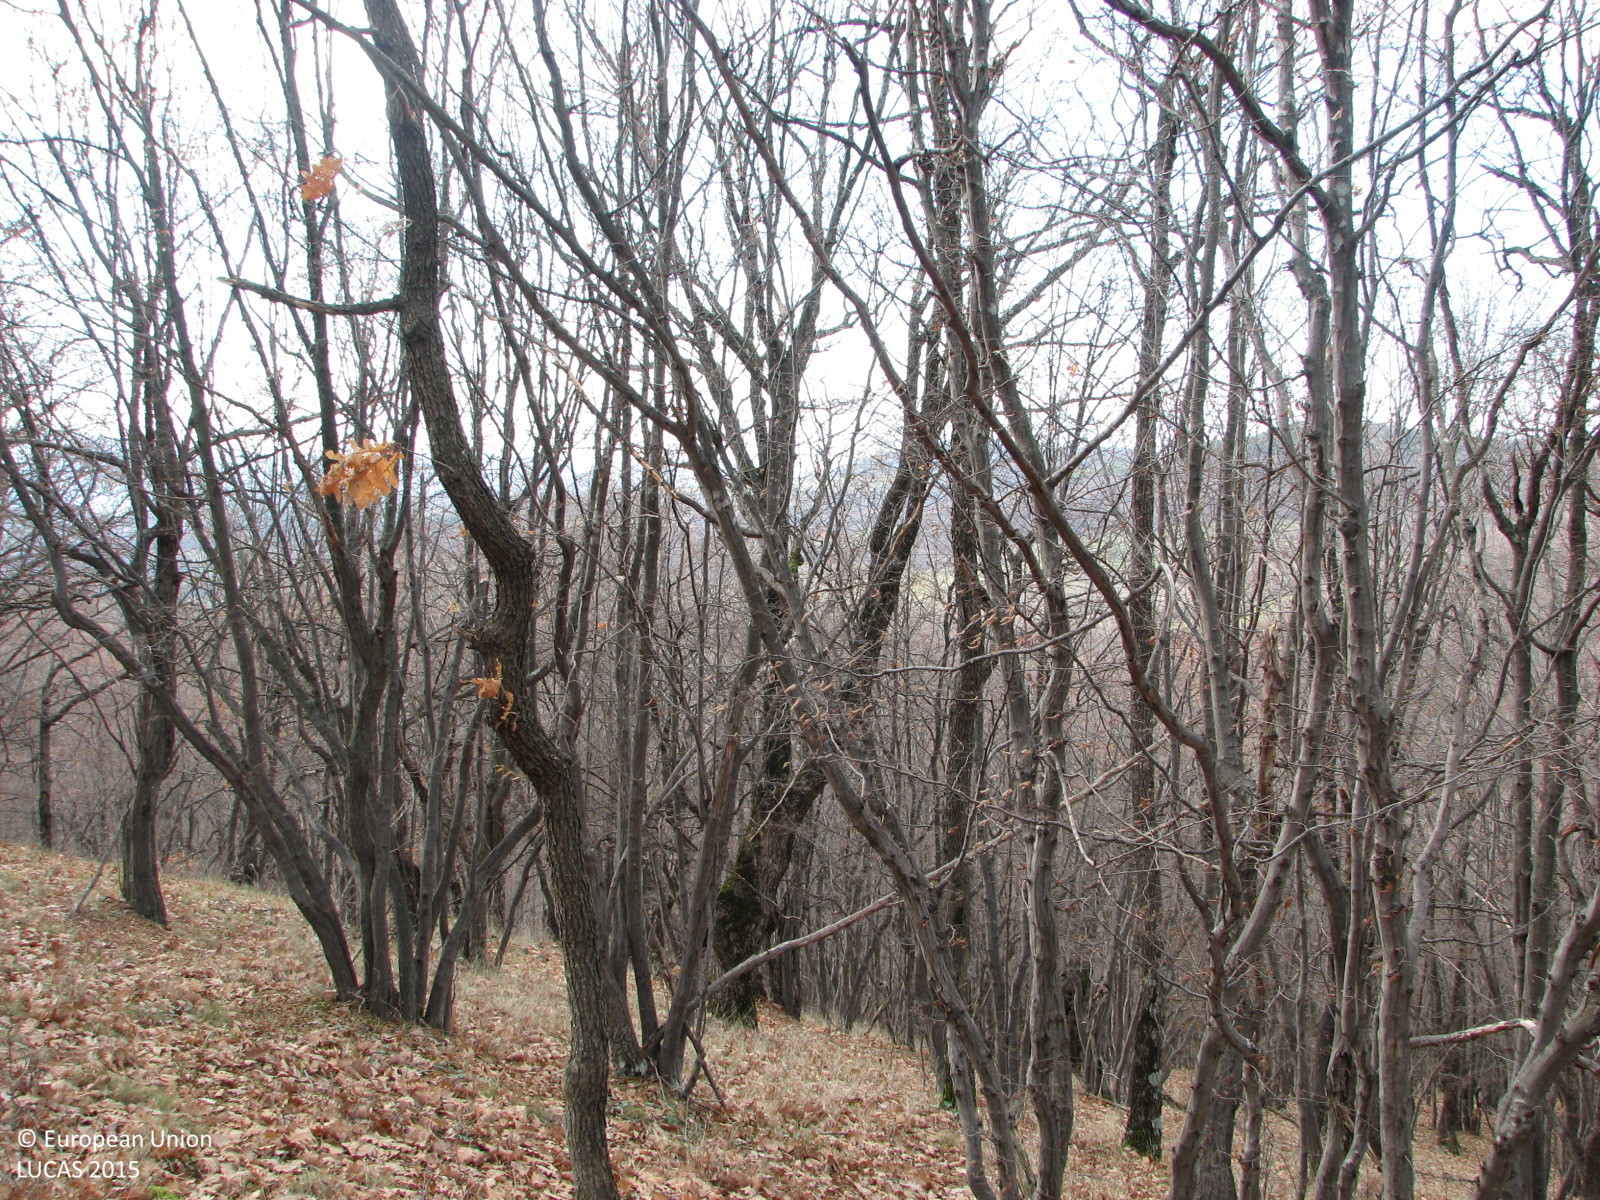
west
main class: Woodland
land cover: Broadleaved woodland
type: mesophytic deciduous forest
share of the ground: > 75 %
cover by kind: broadleaved forest trees 85 %, herbaceous plants 10 %, unconsolidated bare surface 5 %
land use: Semi-natural and natural areas not in use
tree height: < 5 m
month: December
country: BG
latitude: 42.5428
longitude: 24.0844
